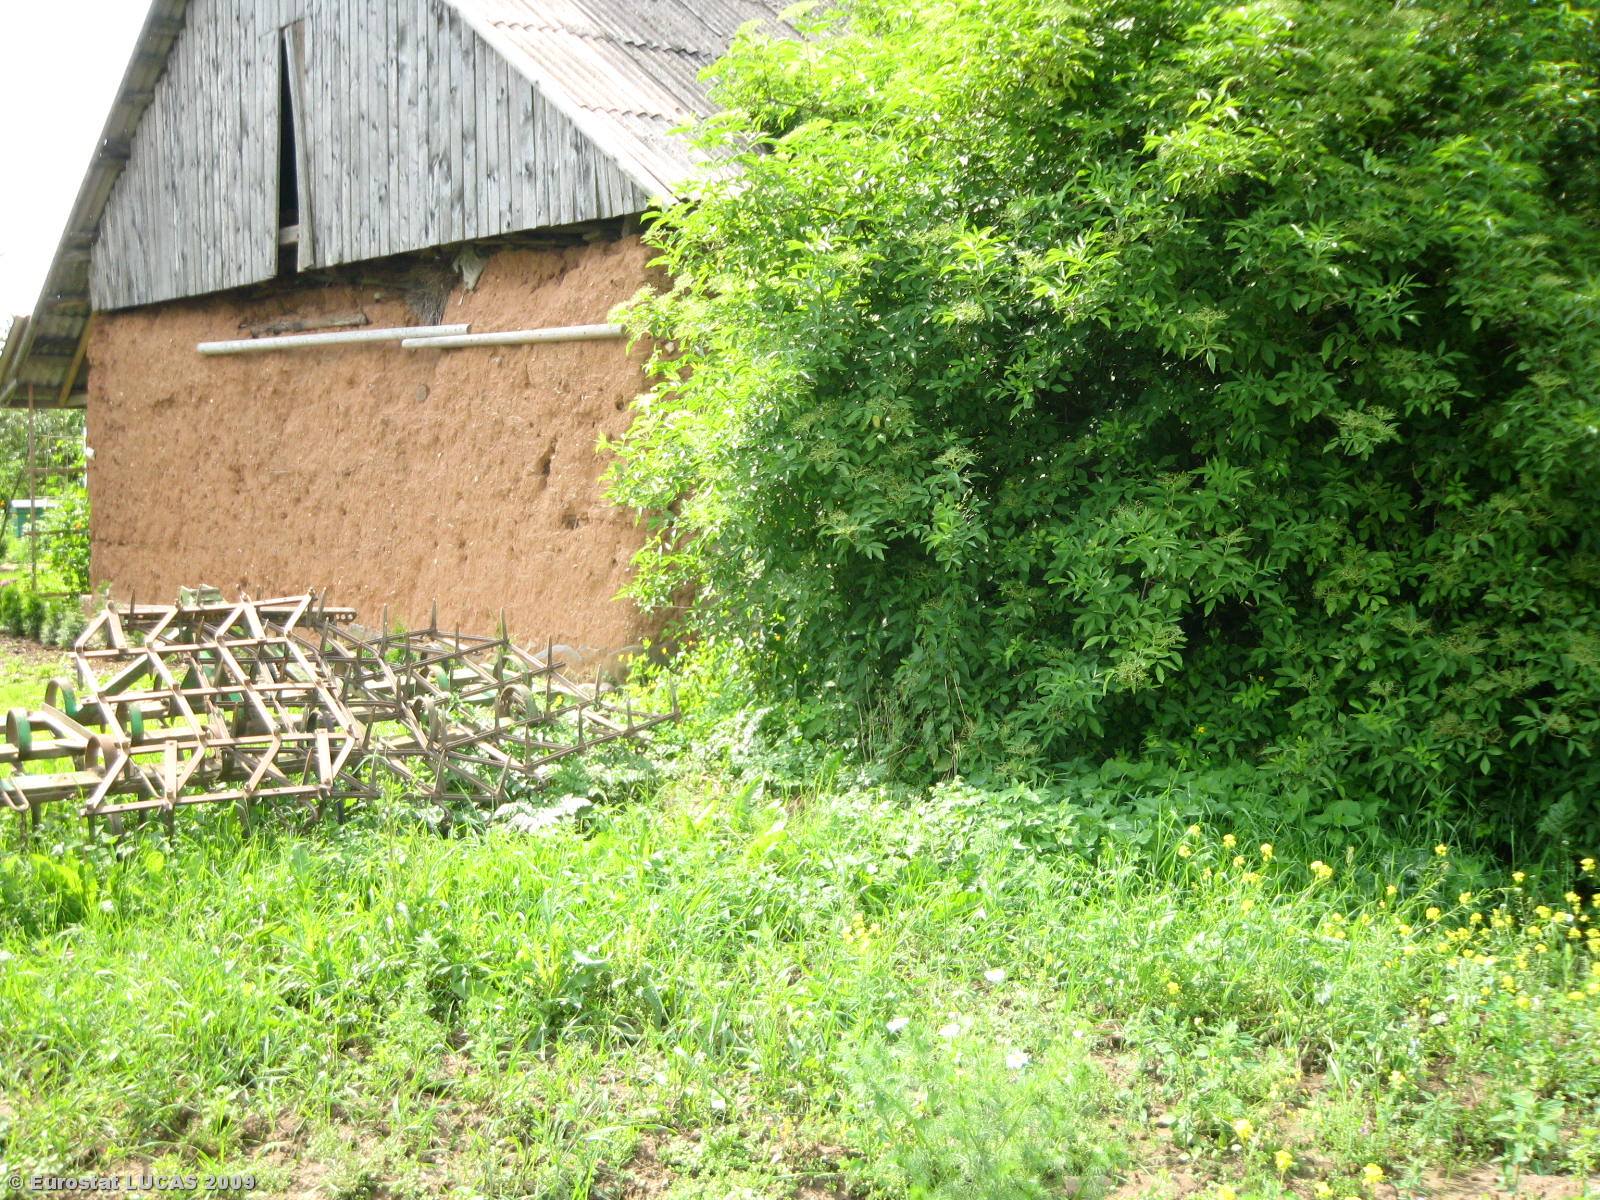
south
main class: Grassland
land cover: Grassland without tree/shrub cover
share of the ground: 25 - 50 %
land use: Fallow land
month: July
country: LT
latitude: 55.2760
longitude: 24.7299
